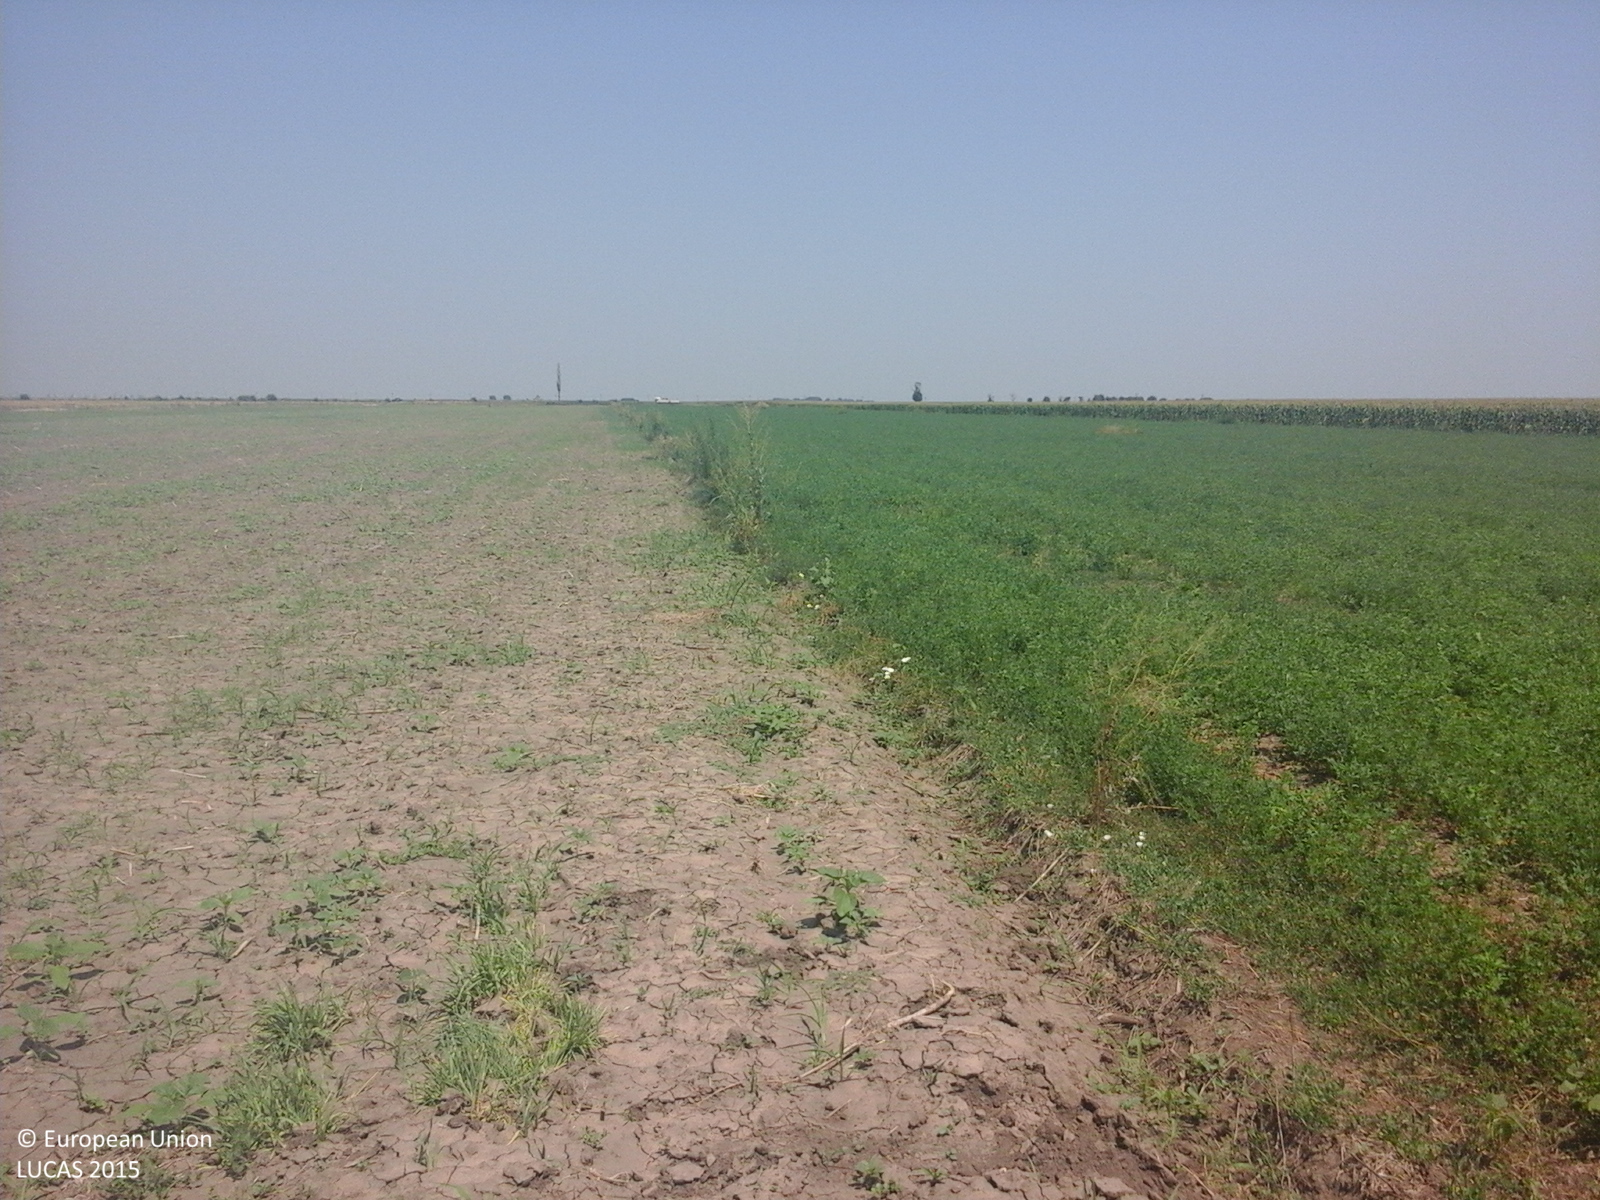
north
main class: Grassland
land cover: Spontaneously vegetated surfaces
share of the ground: > 75 %
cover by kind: herbaceous plants 100 %
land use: Fallow land
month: July
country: RO
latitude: 44.7529
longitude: 27.4627
